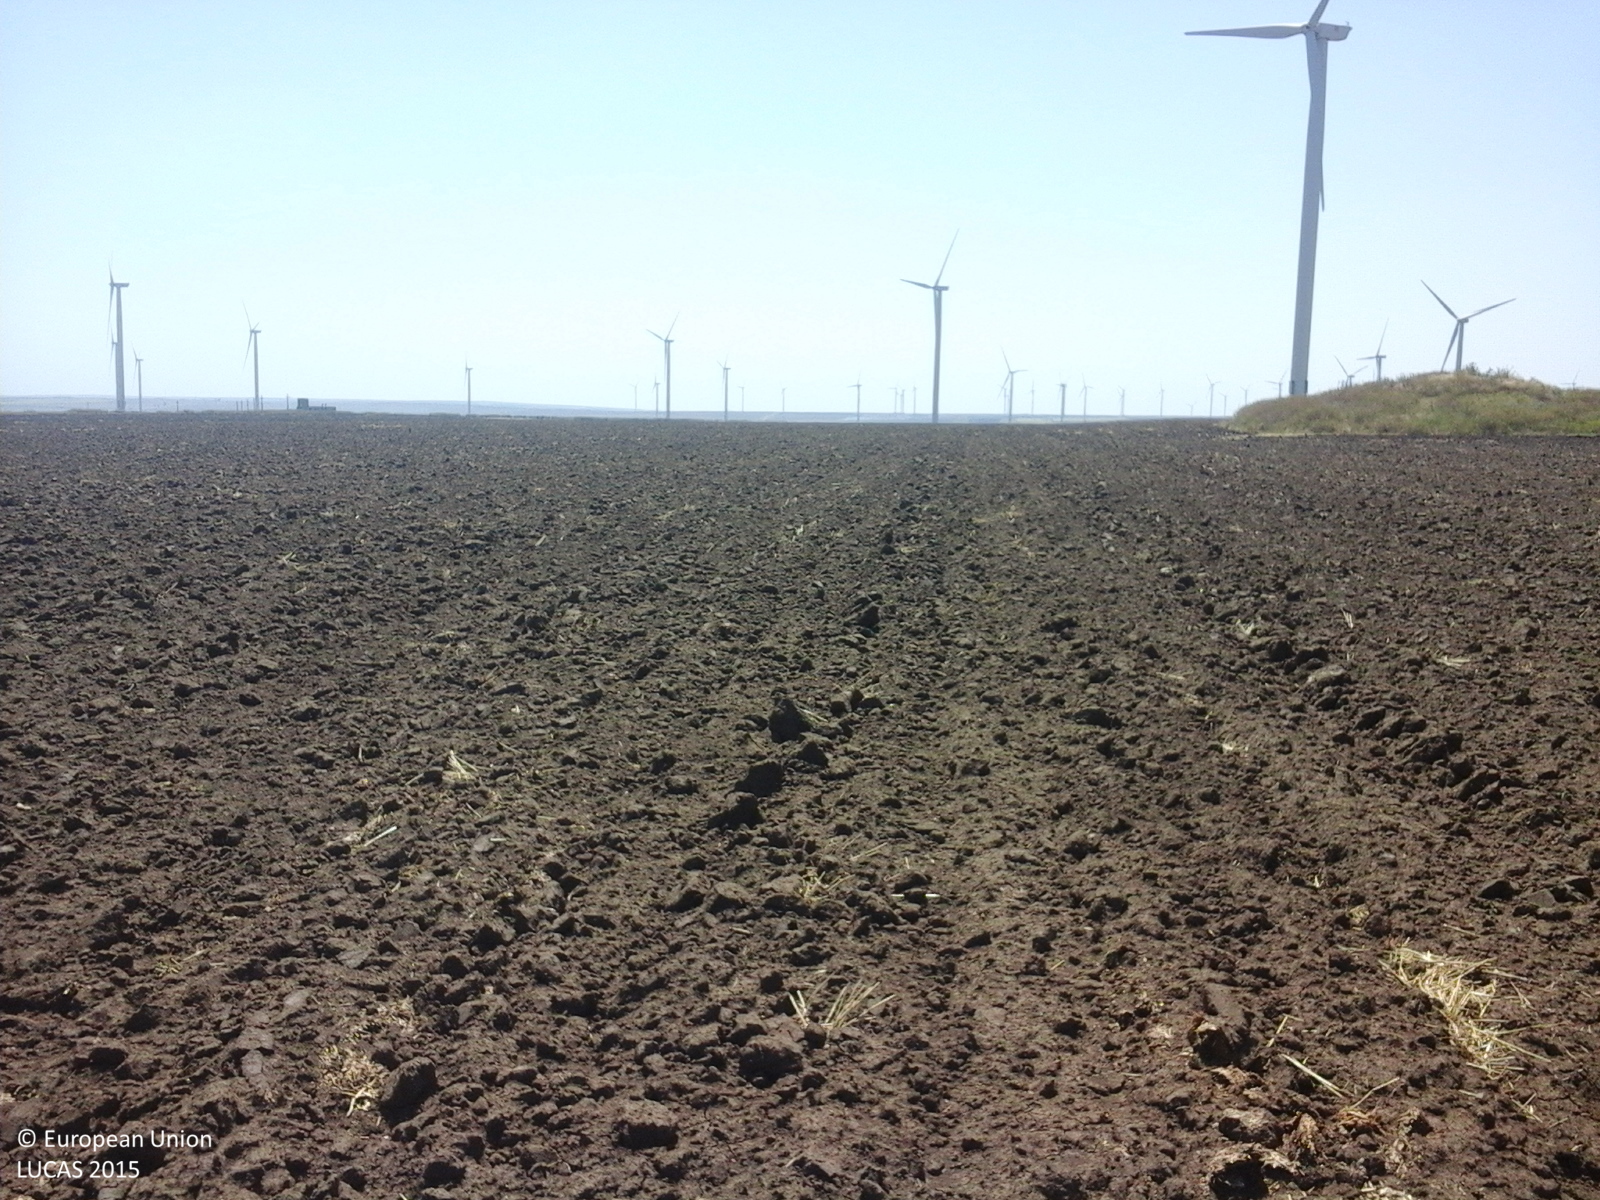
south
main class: Cropland
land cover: Common wheat
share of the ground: < 10 %
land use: Agriculture (excluding fallow land and kitchen gardens)
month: August
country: RO
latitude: 44.6022
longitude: 28.5328
